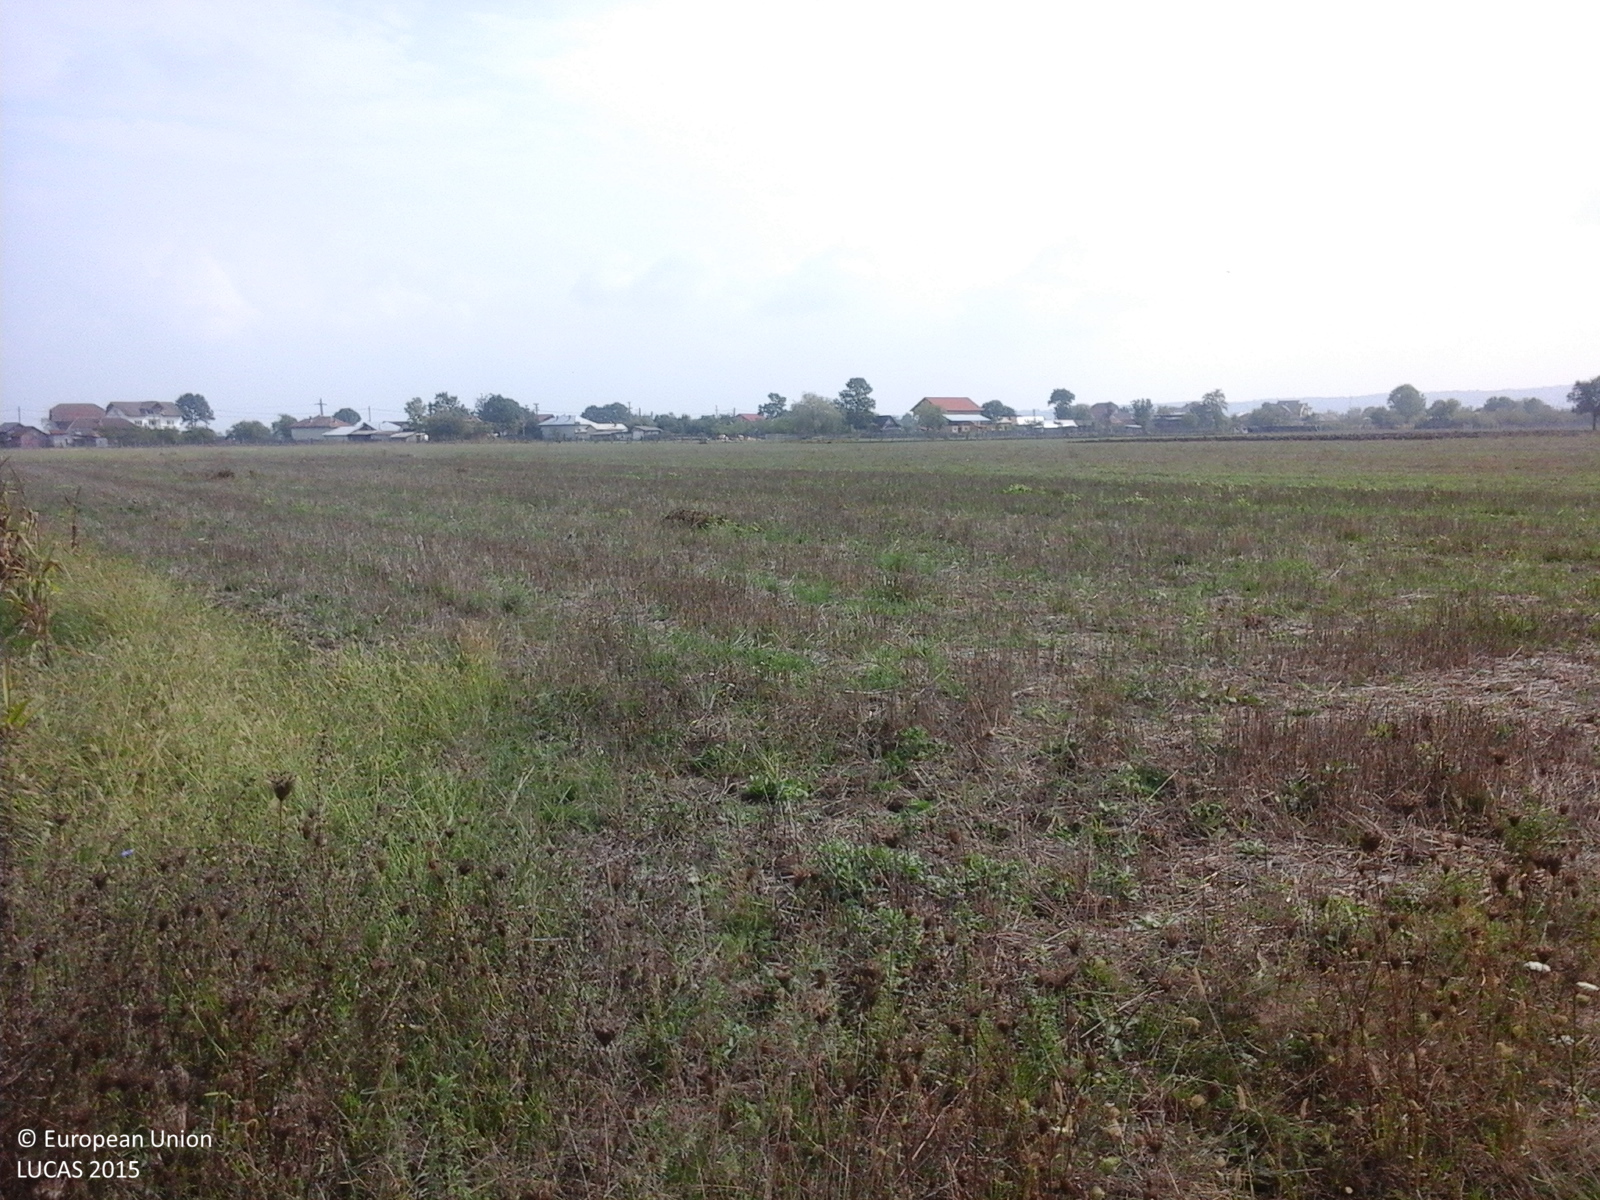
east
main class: Grassland
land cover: Grassland without tree/shrub cover
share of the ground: > 75 %
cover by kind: herbaceous plants 100 %
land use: Agriculture (excluding fallow land and kitchen gardens)
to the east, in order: Grassland without tree/shrub cover; Common wheat; Grassland without tree/shrub cover
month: September
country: RO
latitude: 44.9893
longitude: 23.2826
